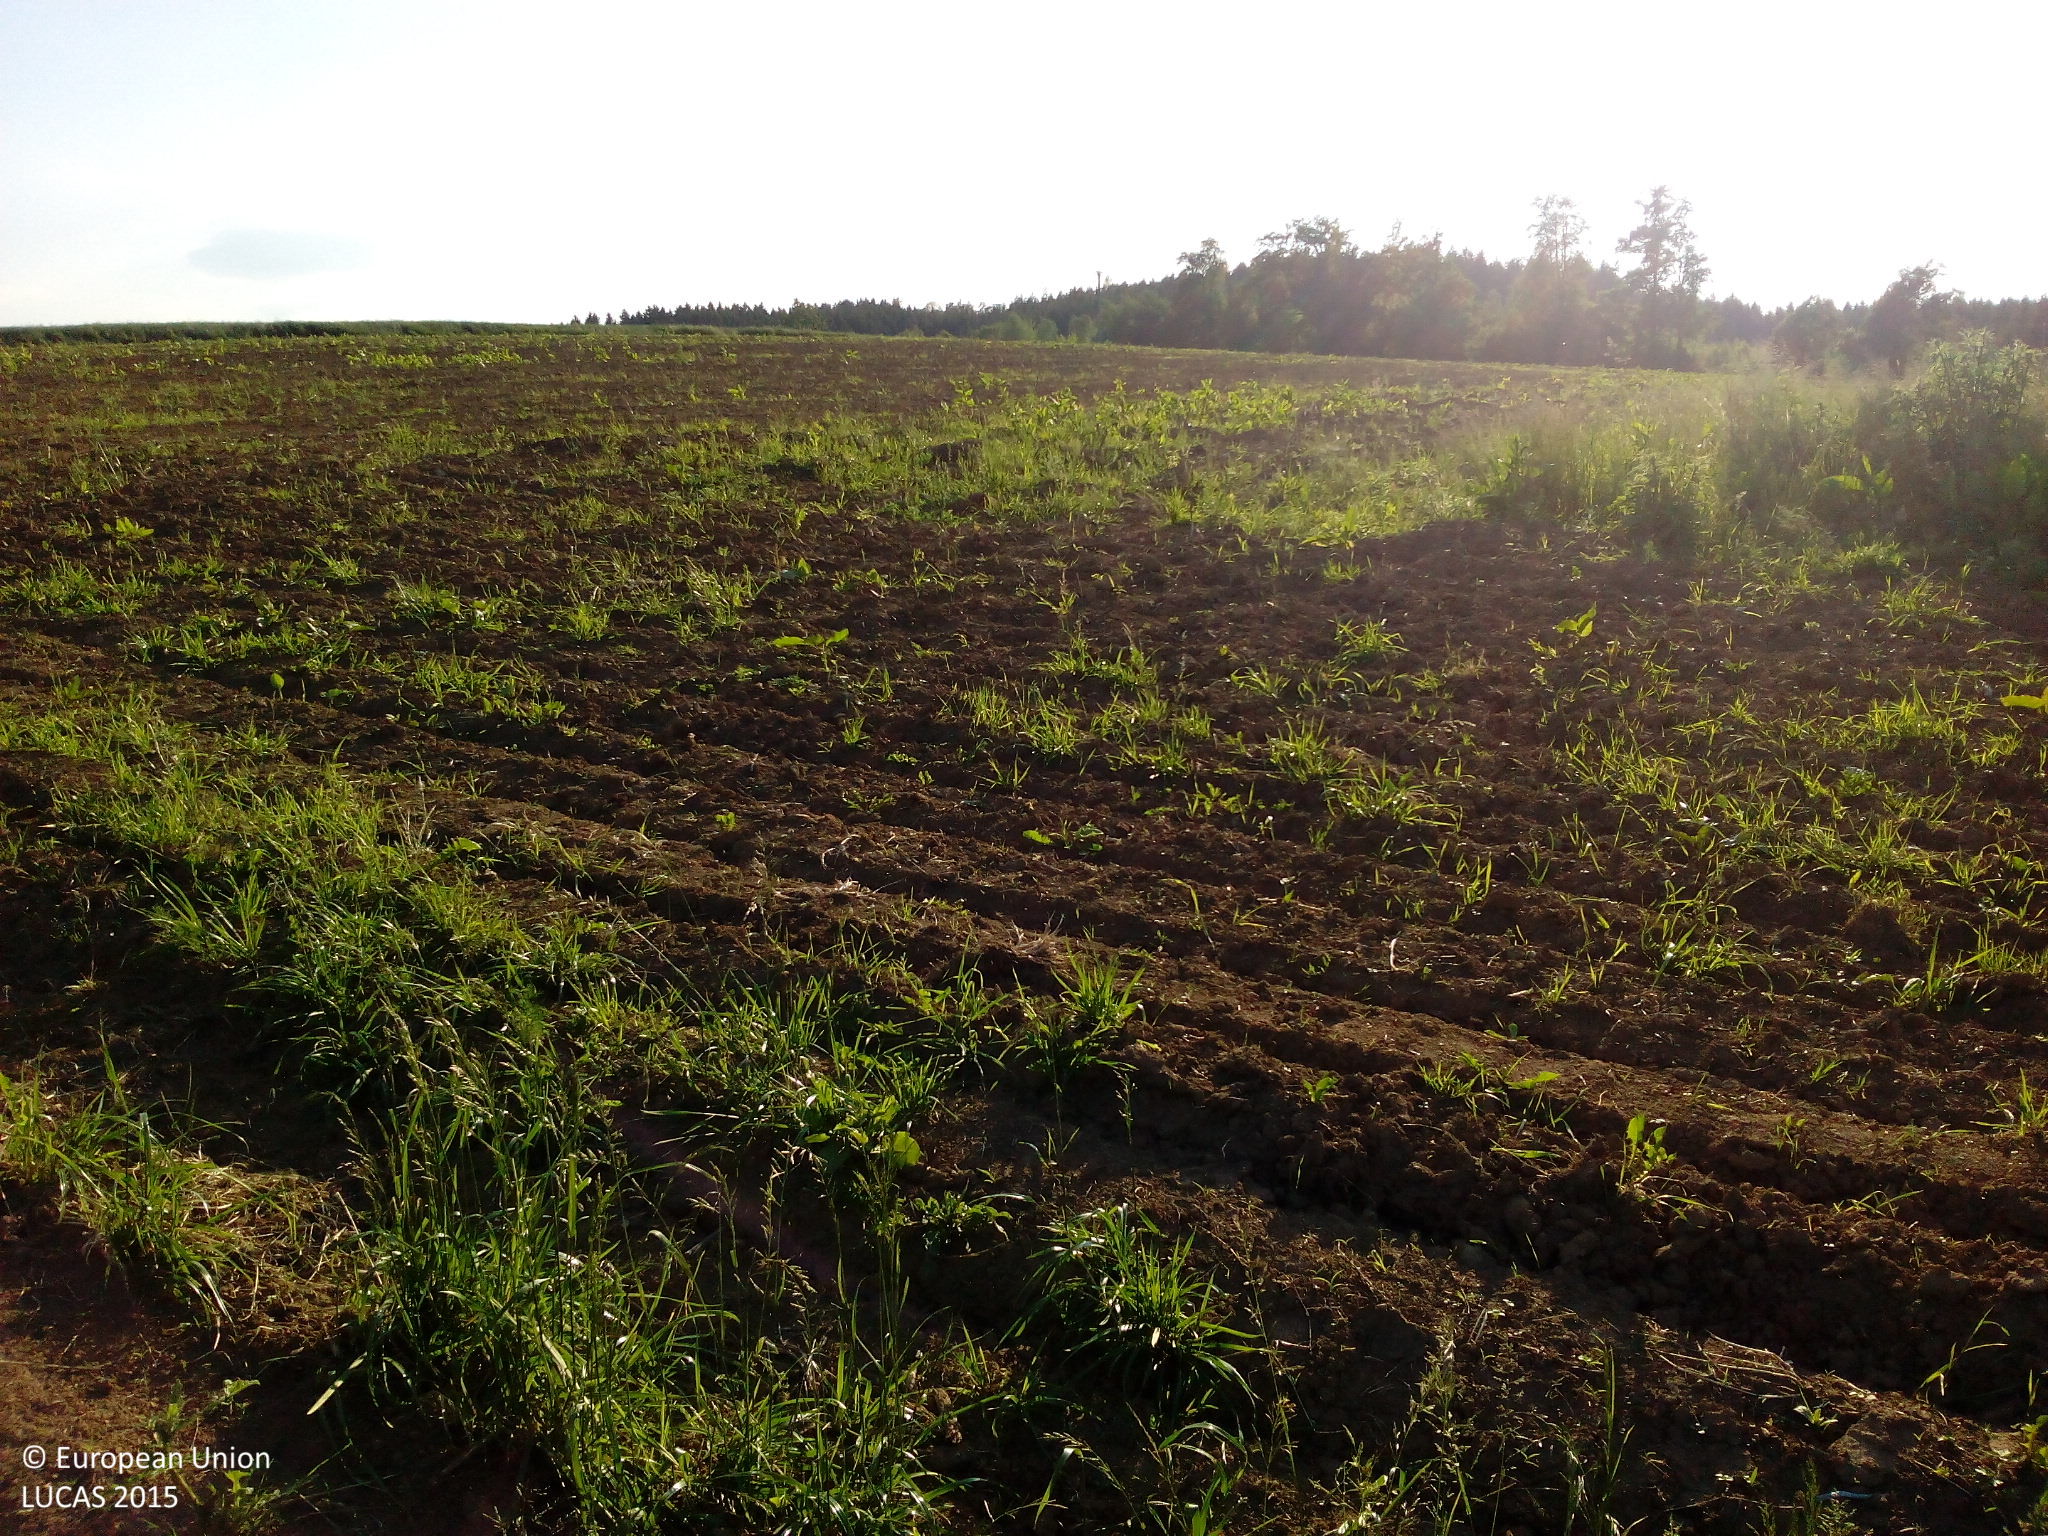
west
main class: Cropland
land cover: Common wheat
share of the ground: > 75 %
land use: Agriculture (excluding fallow land and kitchen gardens)
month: June
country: DE
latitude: 48.8698
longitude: 12.0852
